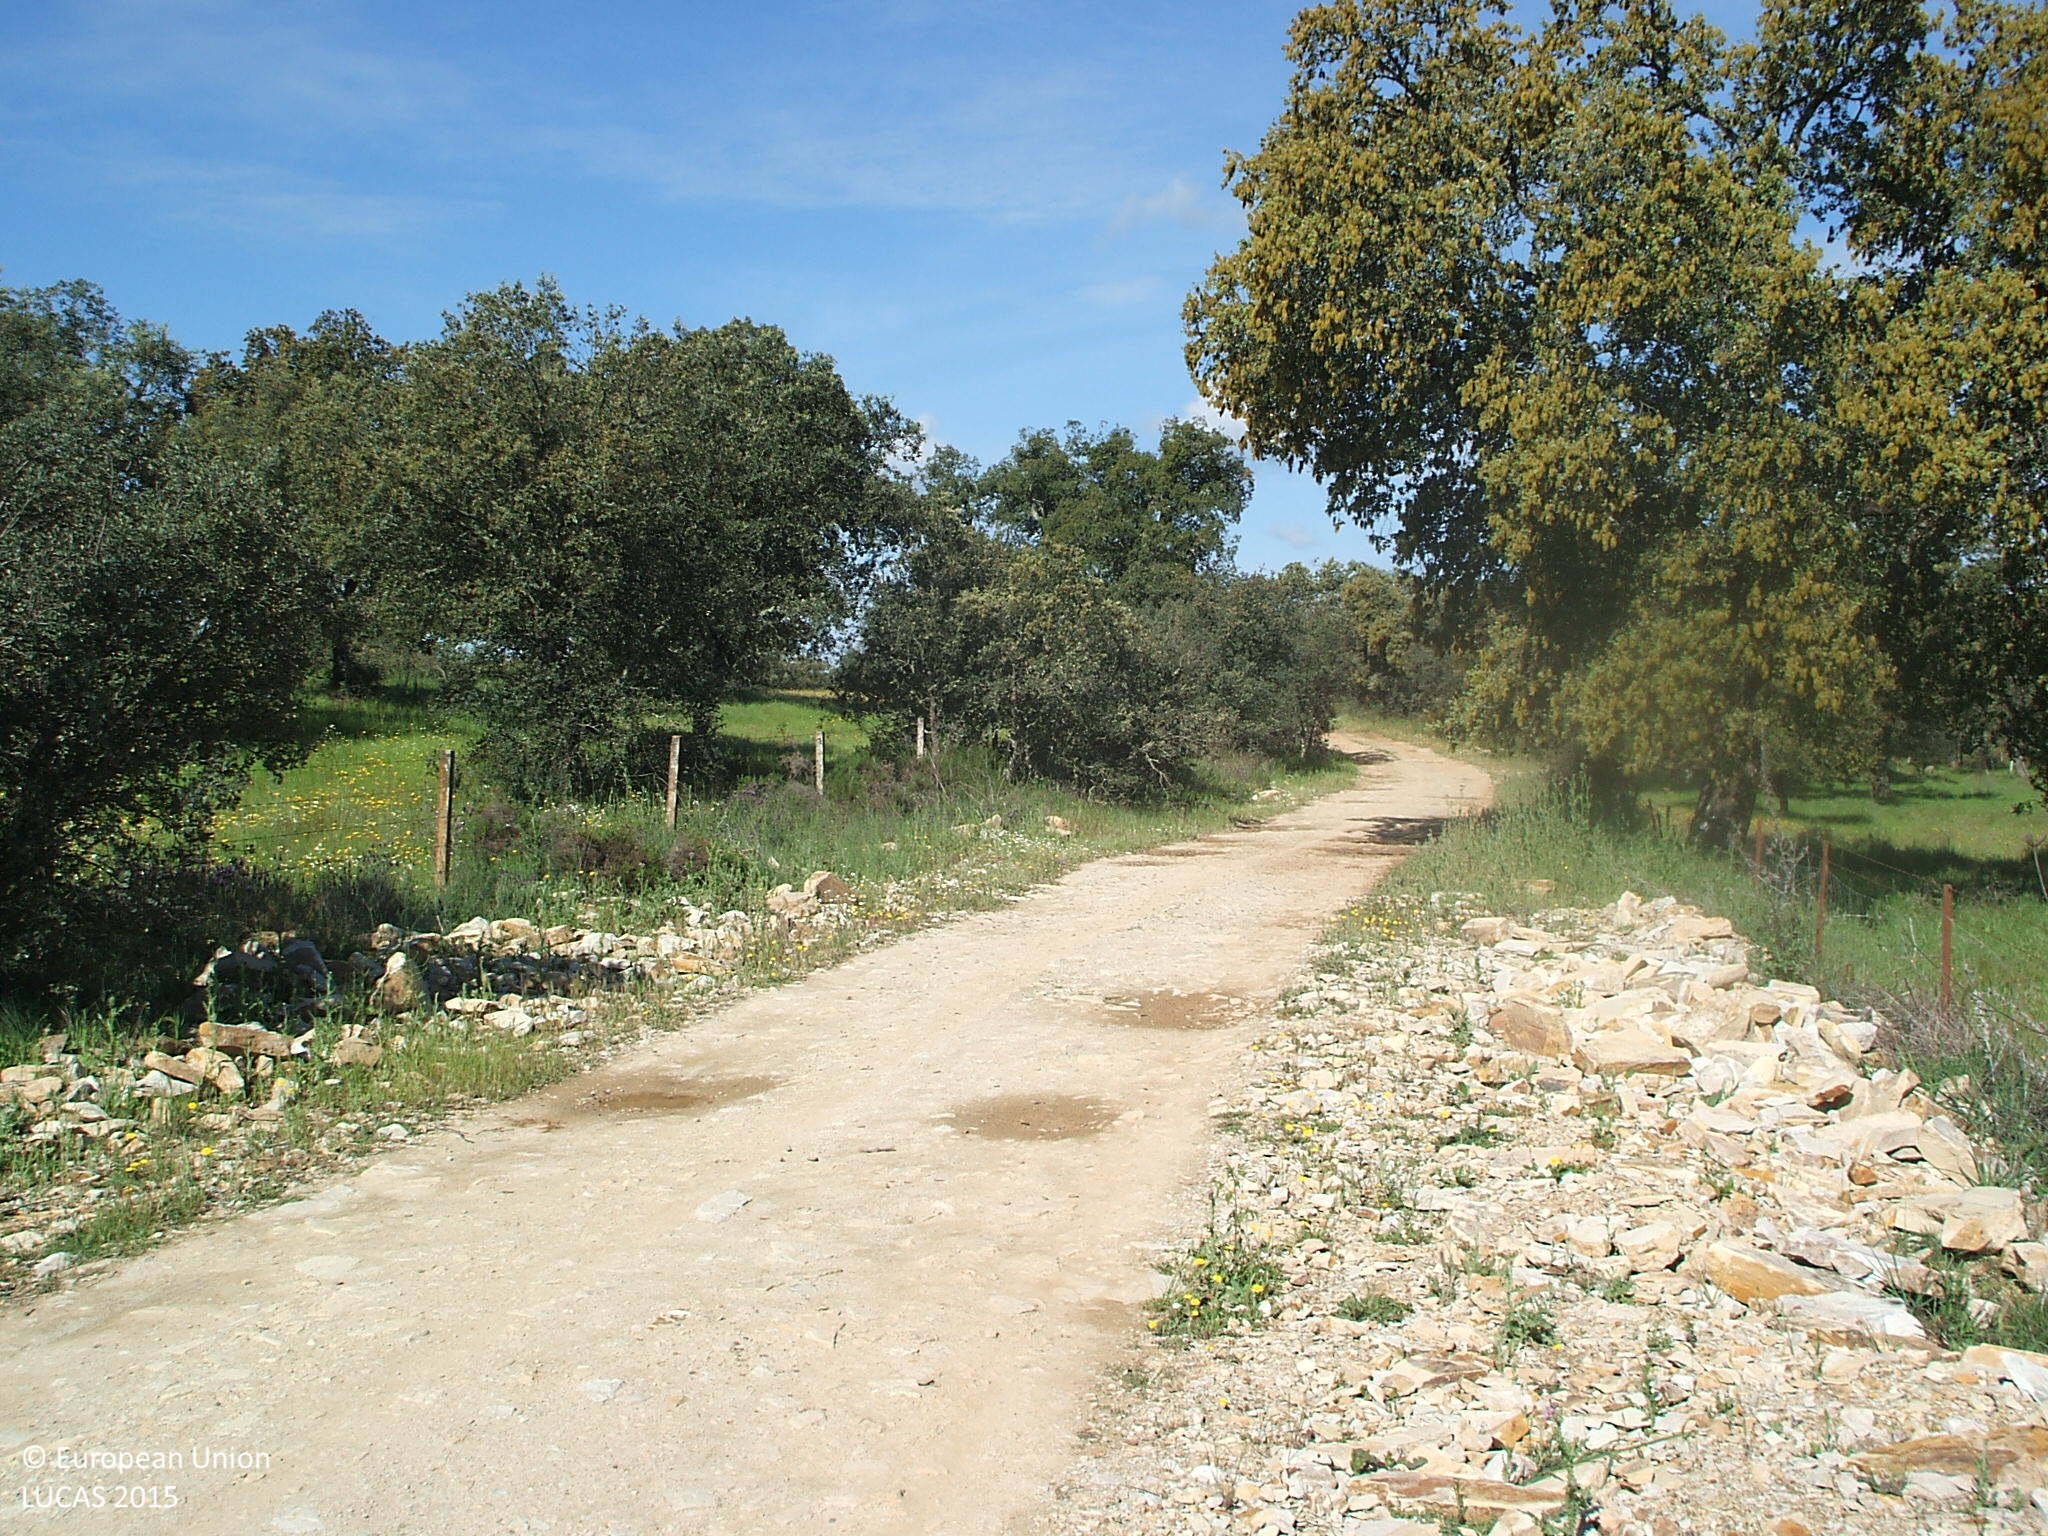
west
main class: Woodland
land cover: Broadleaved woodland
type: broadleaved evergreen forest
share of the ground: 25 - 50 %
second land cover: Grassland without tree/shrub cover
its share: > 75 %
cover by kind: herbaceous plants 75 %, broadleaved forest trees 25 %
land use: Forestry
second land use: Agriculture (excluding fallow land and kitchen gardens)
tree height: > 5 m
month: April
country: ES
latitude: 38.0136
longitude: -5.6221
